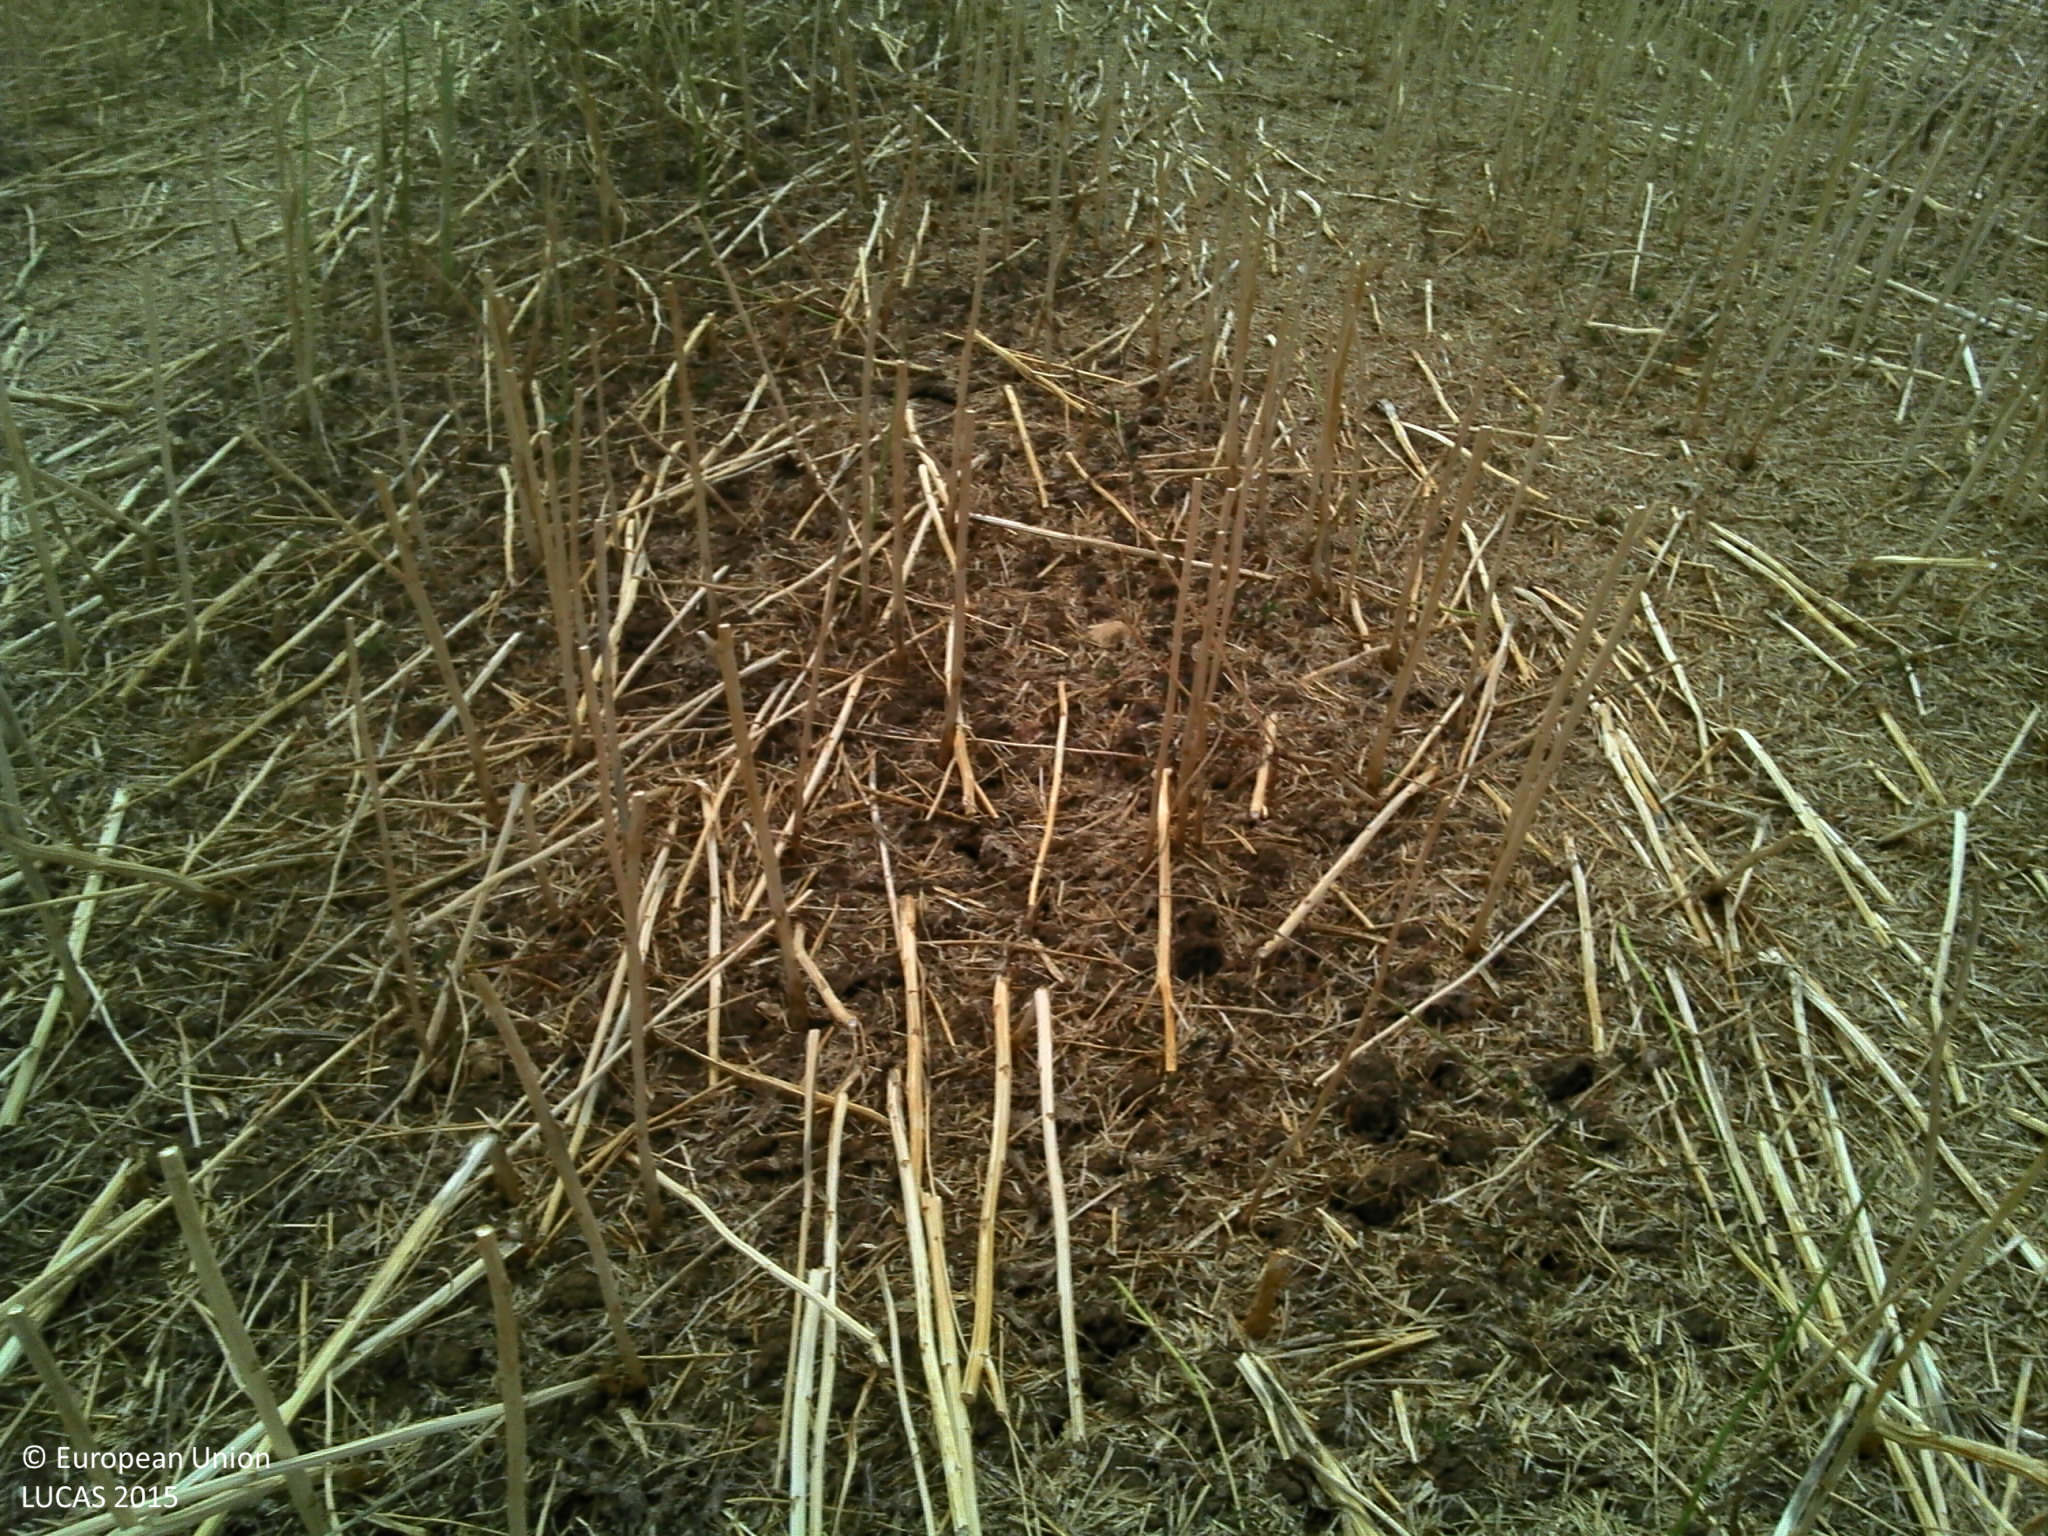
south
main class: Cropland
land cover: Rape and turnip rape
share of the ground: 25 - 50 %
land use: Agriculture (excluding fallow land and kitchen gardens)
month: July
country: FR
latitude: 46.9666
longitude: 2.1454
